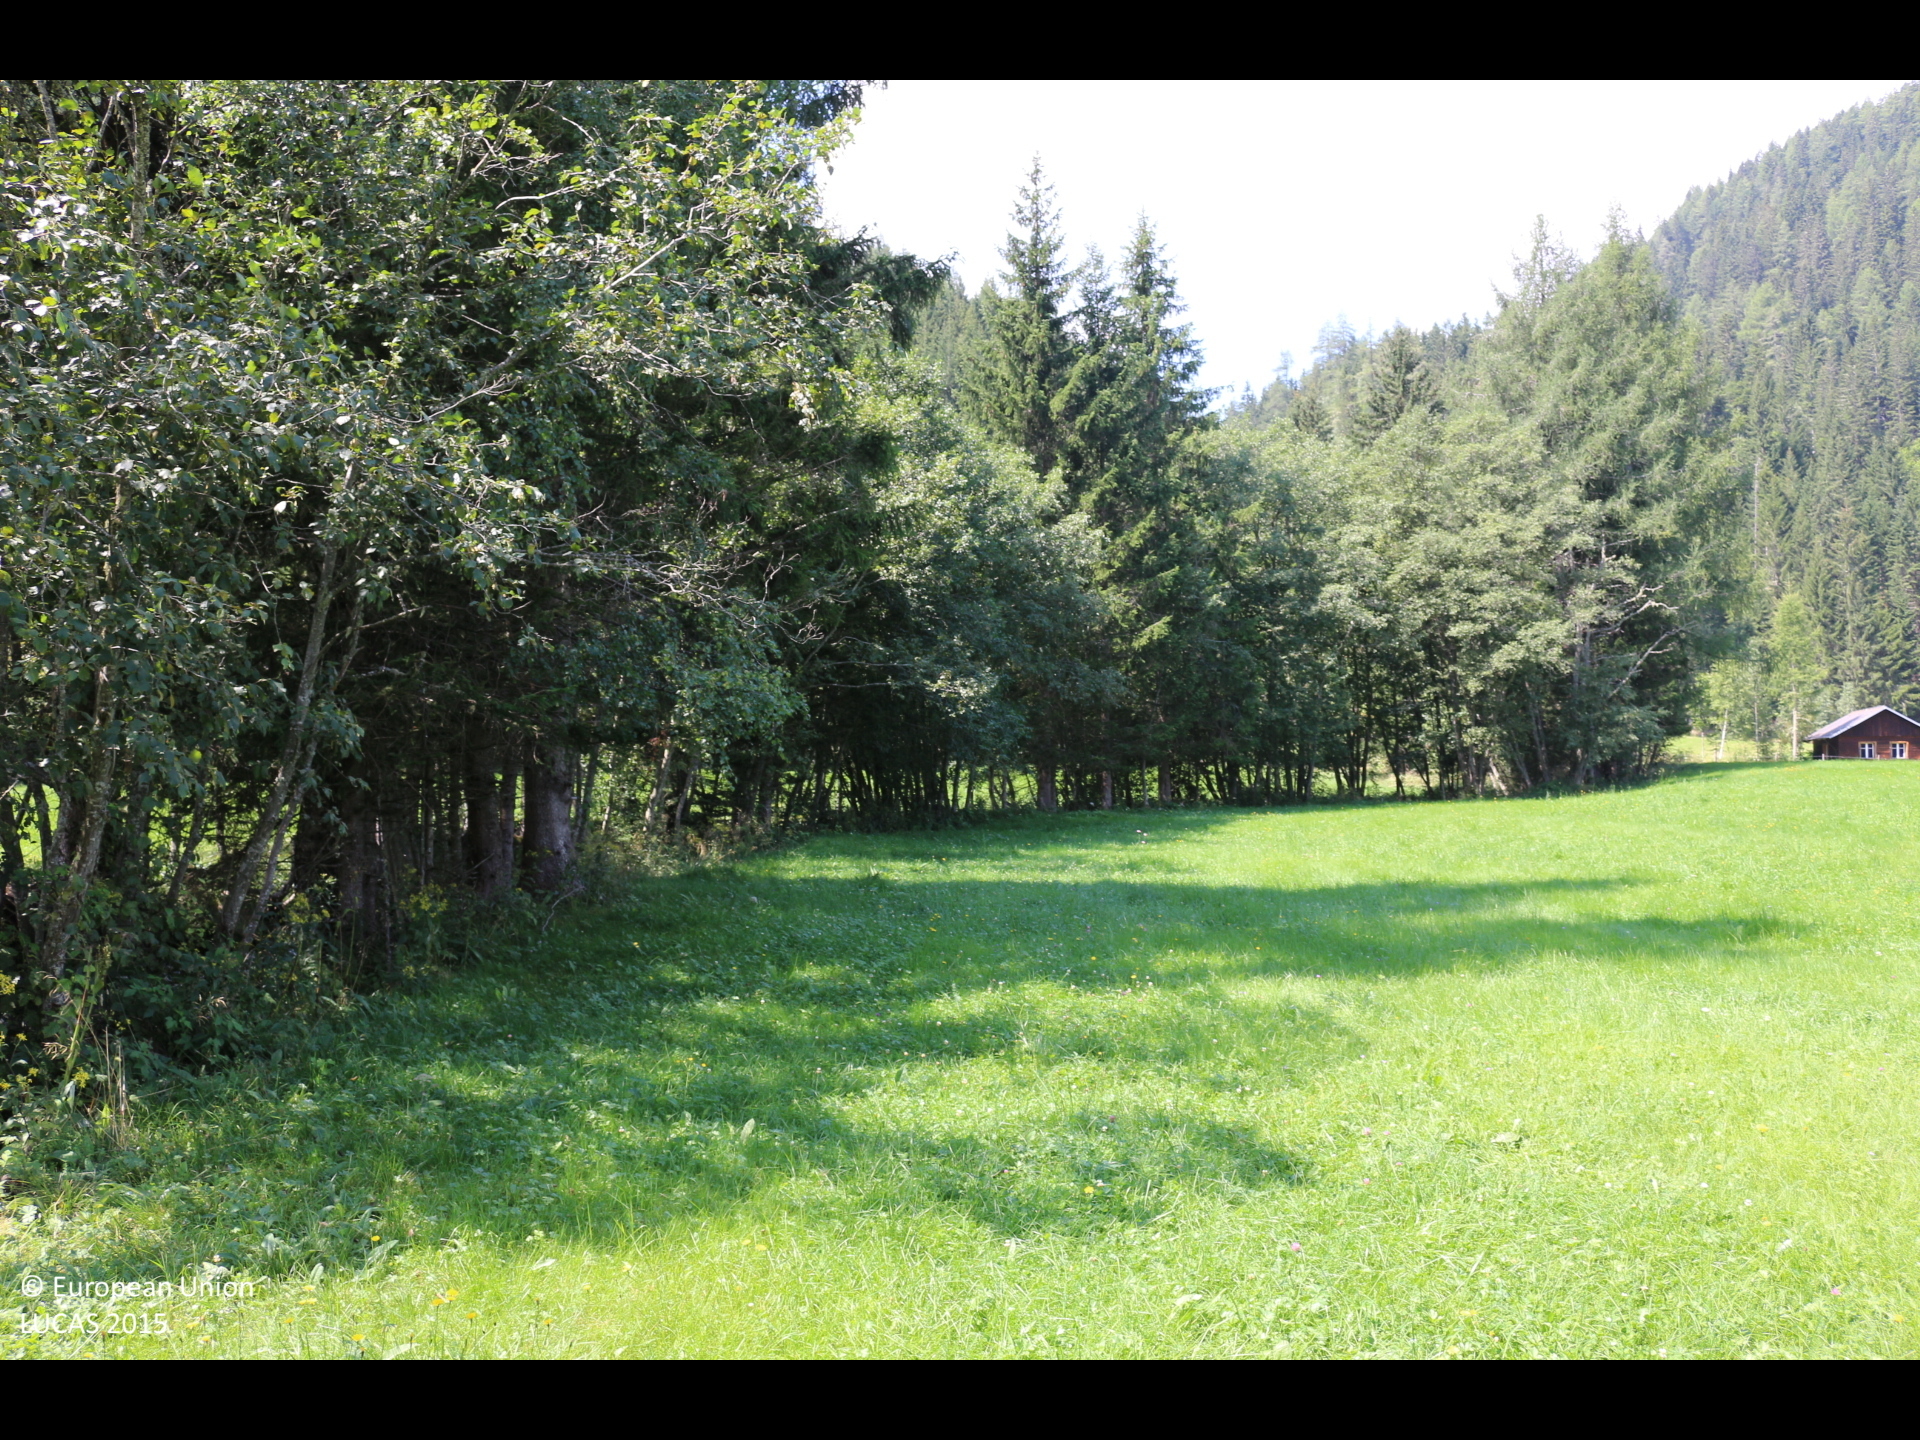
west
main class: Grassland
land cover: Grassland without tree/shrub cover
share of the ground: > 75 %
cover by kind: herbaceous plants 100 %
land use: Agriculture (excluding fallow land and kitchen gardens)
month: August
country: AT
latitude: 47.0283
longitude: 14.1428
